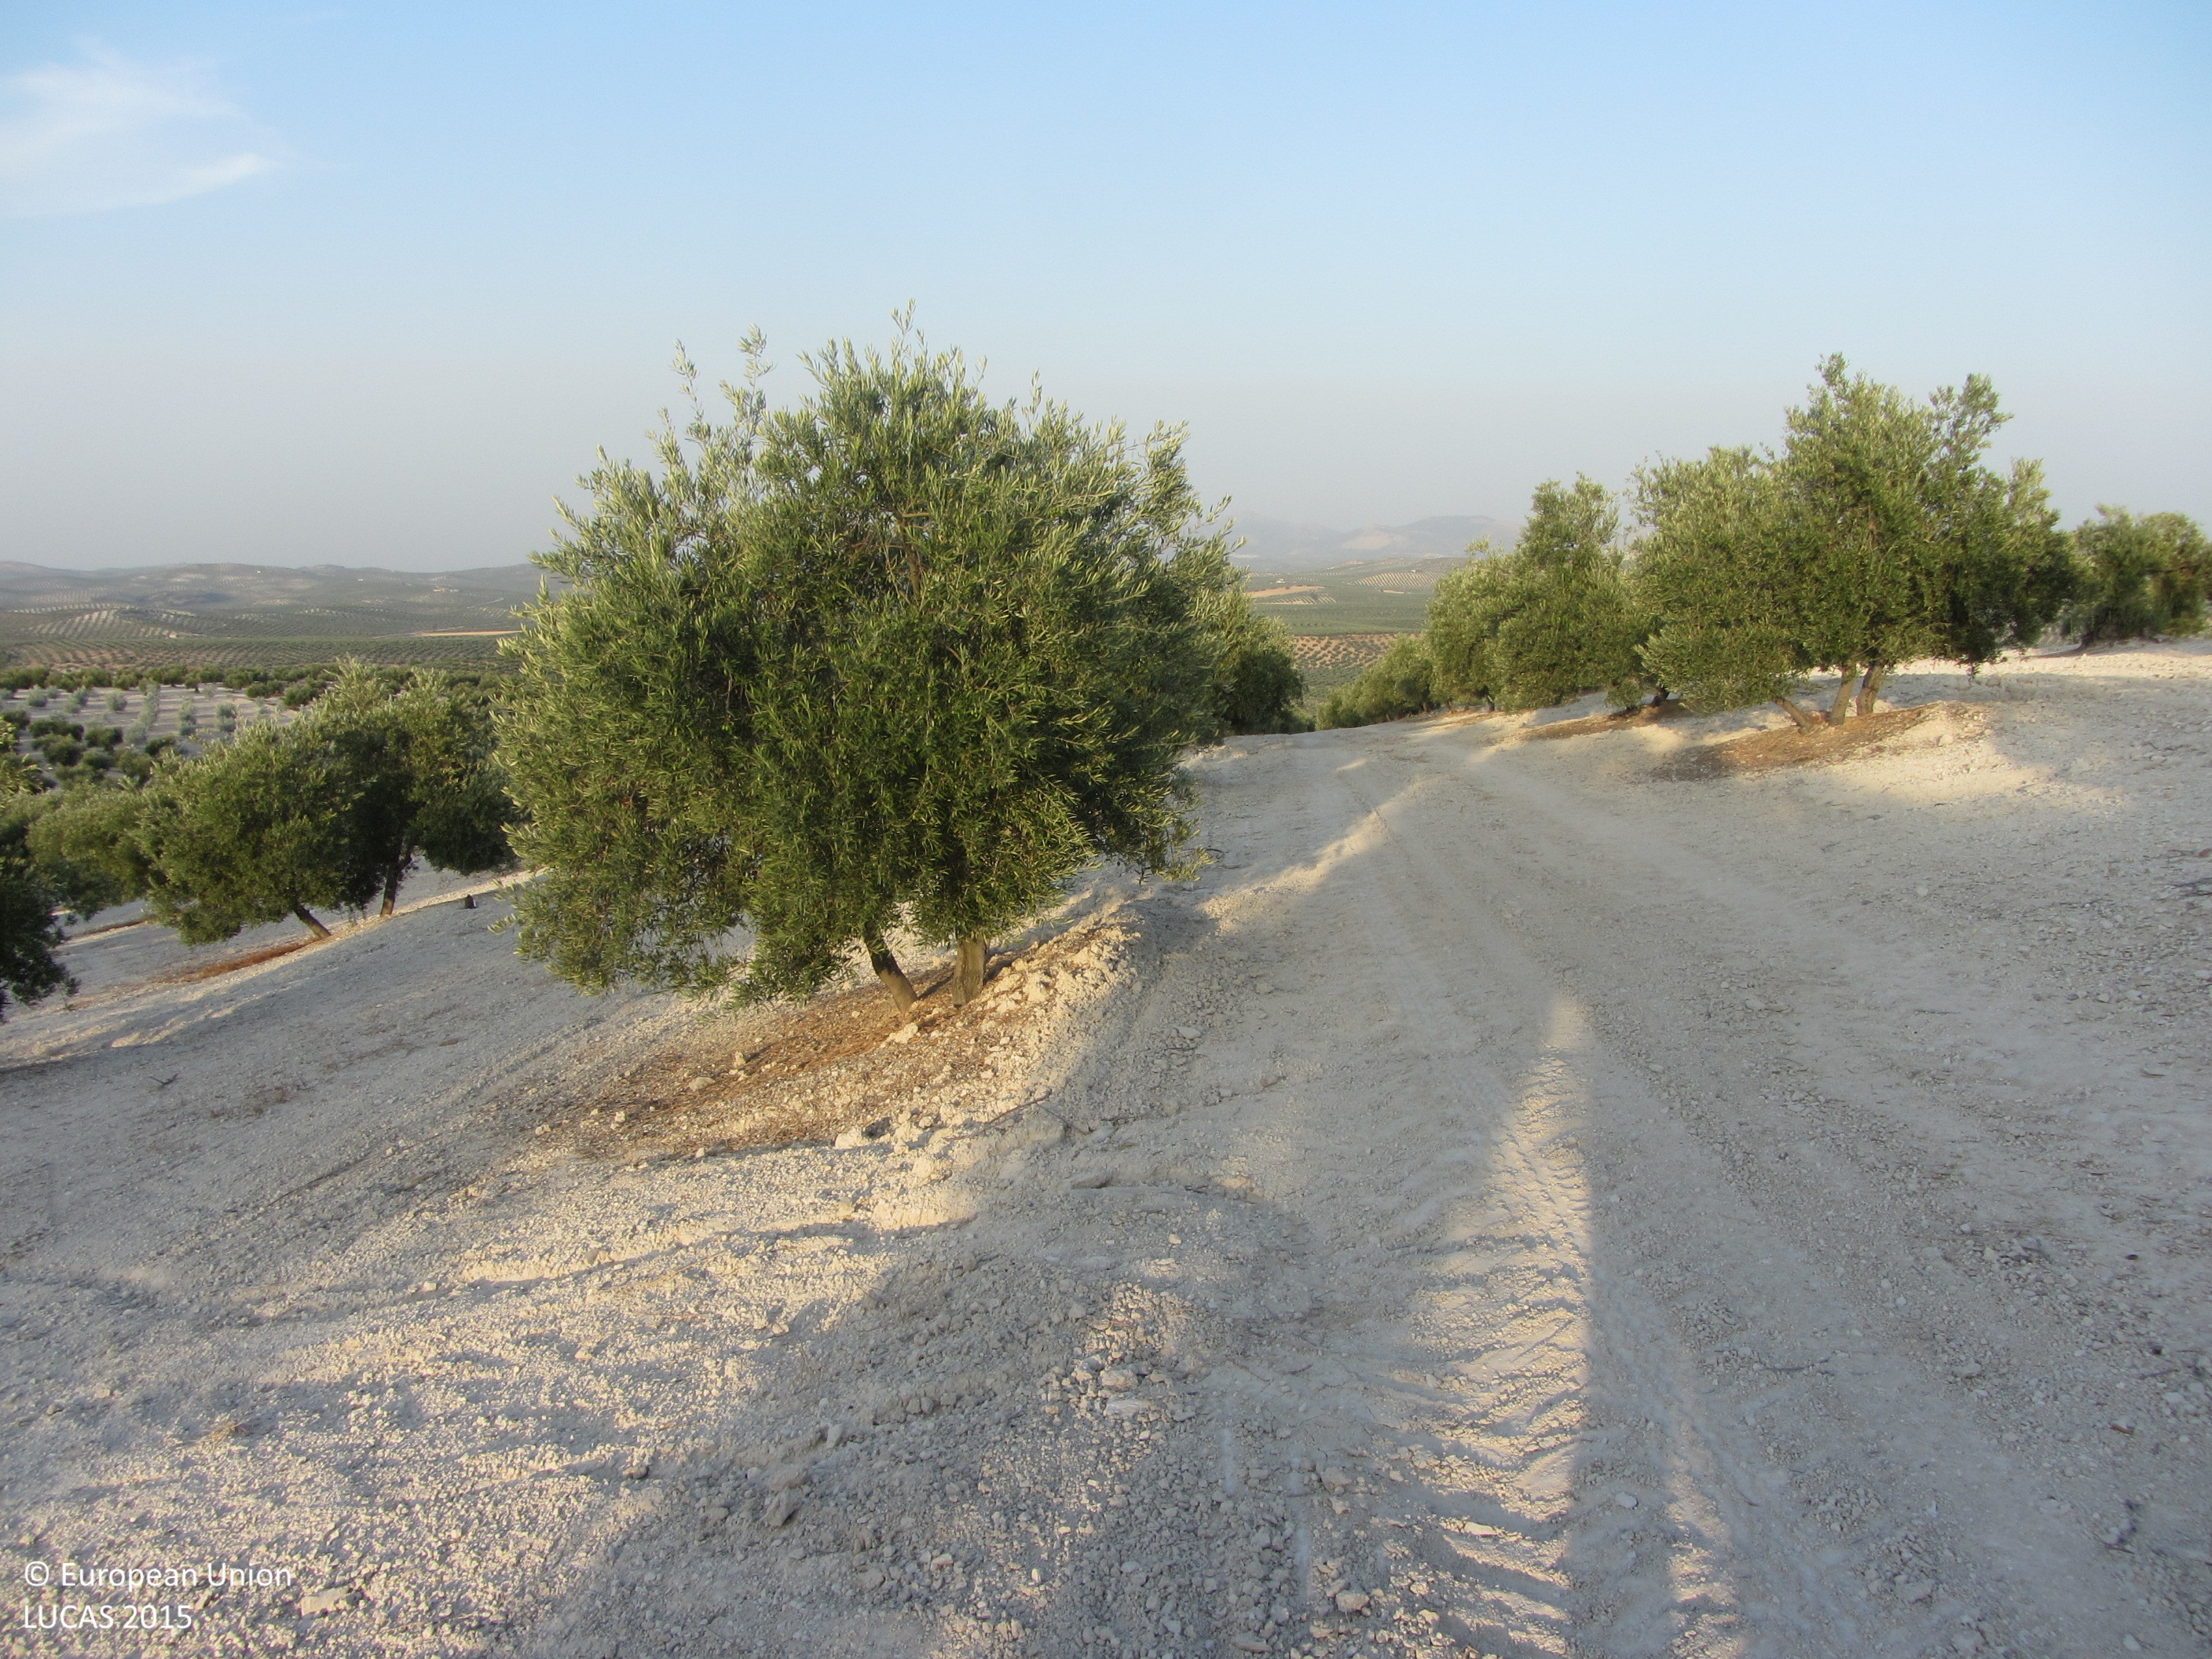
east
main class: Cropland
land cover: Olive groves
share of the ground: 10 - 25 %
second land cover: Other bare soil
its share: > 75 %
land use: Agriculture (excluding fallow land and kitchen gardens)
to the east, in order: Olive groves; Other bare soil; Tracks; Olive groves; Other structural elements; Olive groves
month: July
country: ES
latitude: 37.7840
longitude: -4.1643
